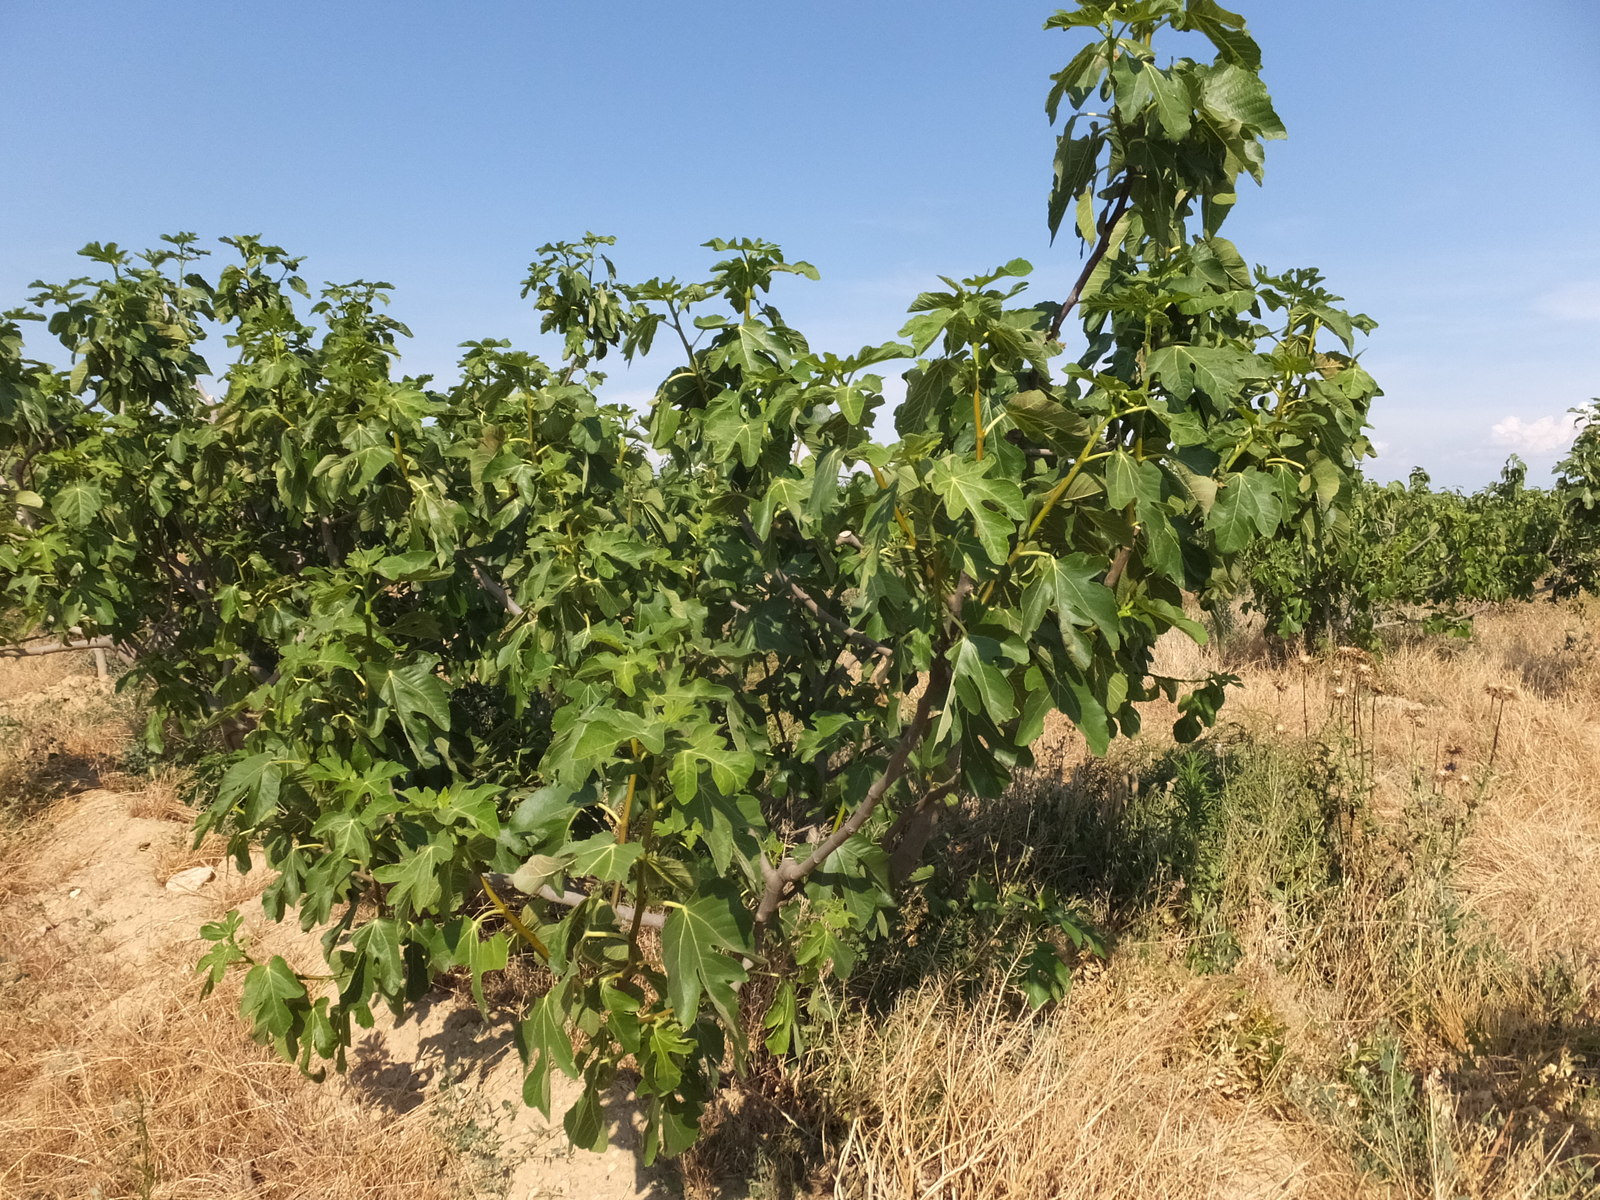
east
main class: Cropland
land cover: Other fruit trees and berries
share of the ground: > 75 %
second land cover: Spontaneously vegetated surfaces
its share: 10 - 25 %
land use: Agriculture (excluding fallow land and kitchen gardens)
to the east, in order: Other fruit trees and berries; Spontaneously vegetated surfaces; Tracks; Shruby margins; Ditches and canals; Shruby margins; Rice; Shruby margins; Single bushes/trees; Maize
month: June
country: ES
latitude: 41.7996
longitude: 0.0543
